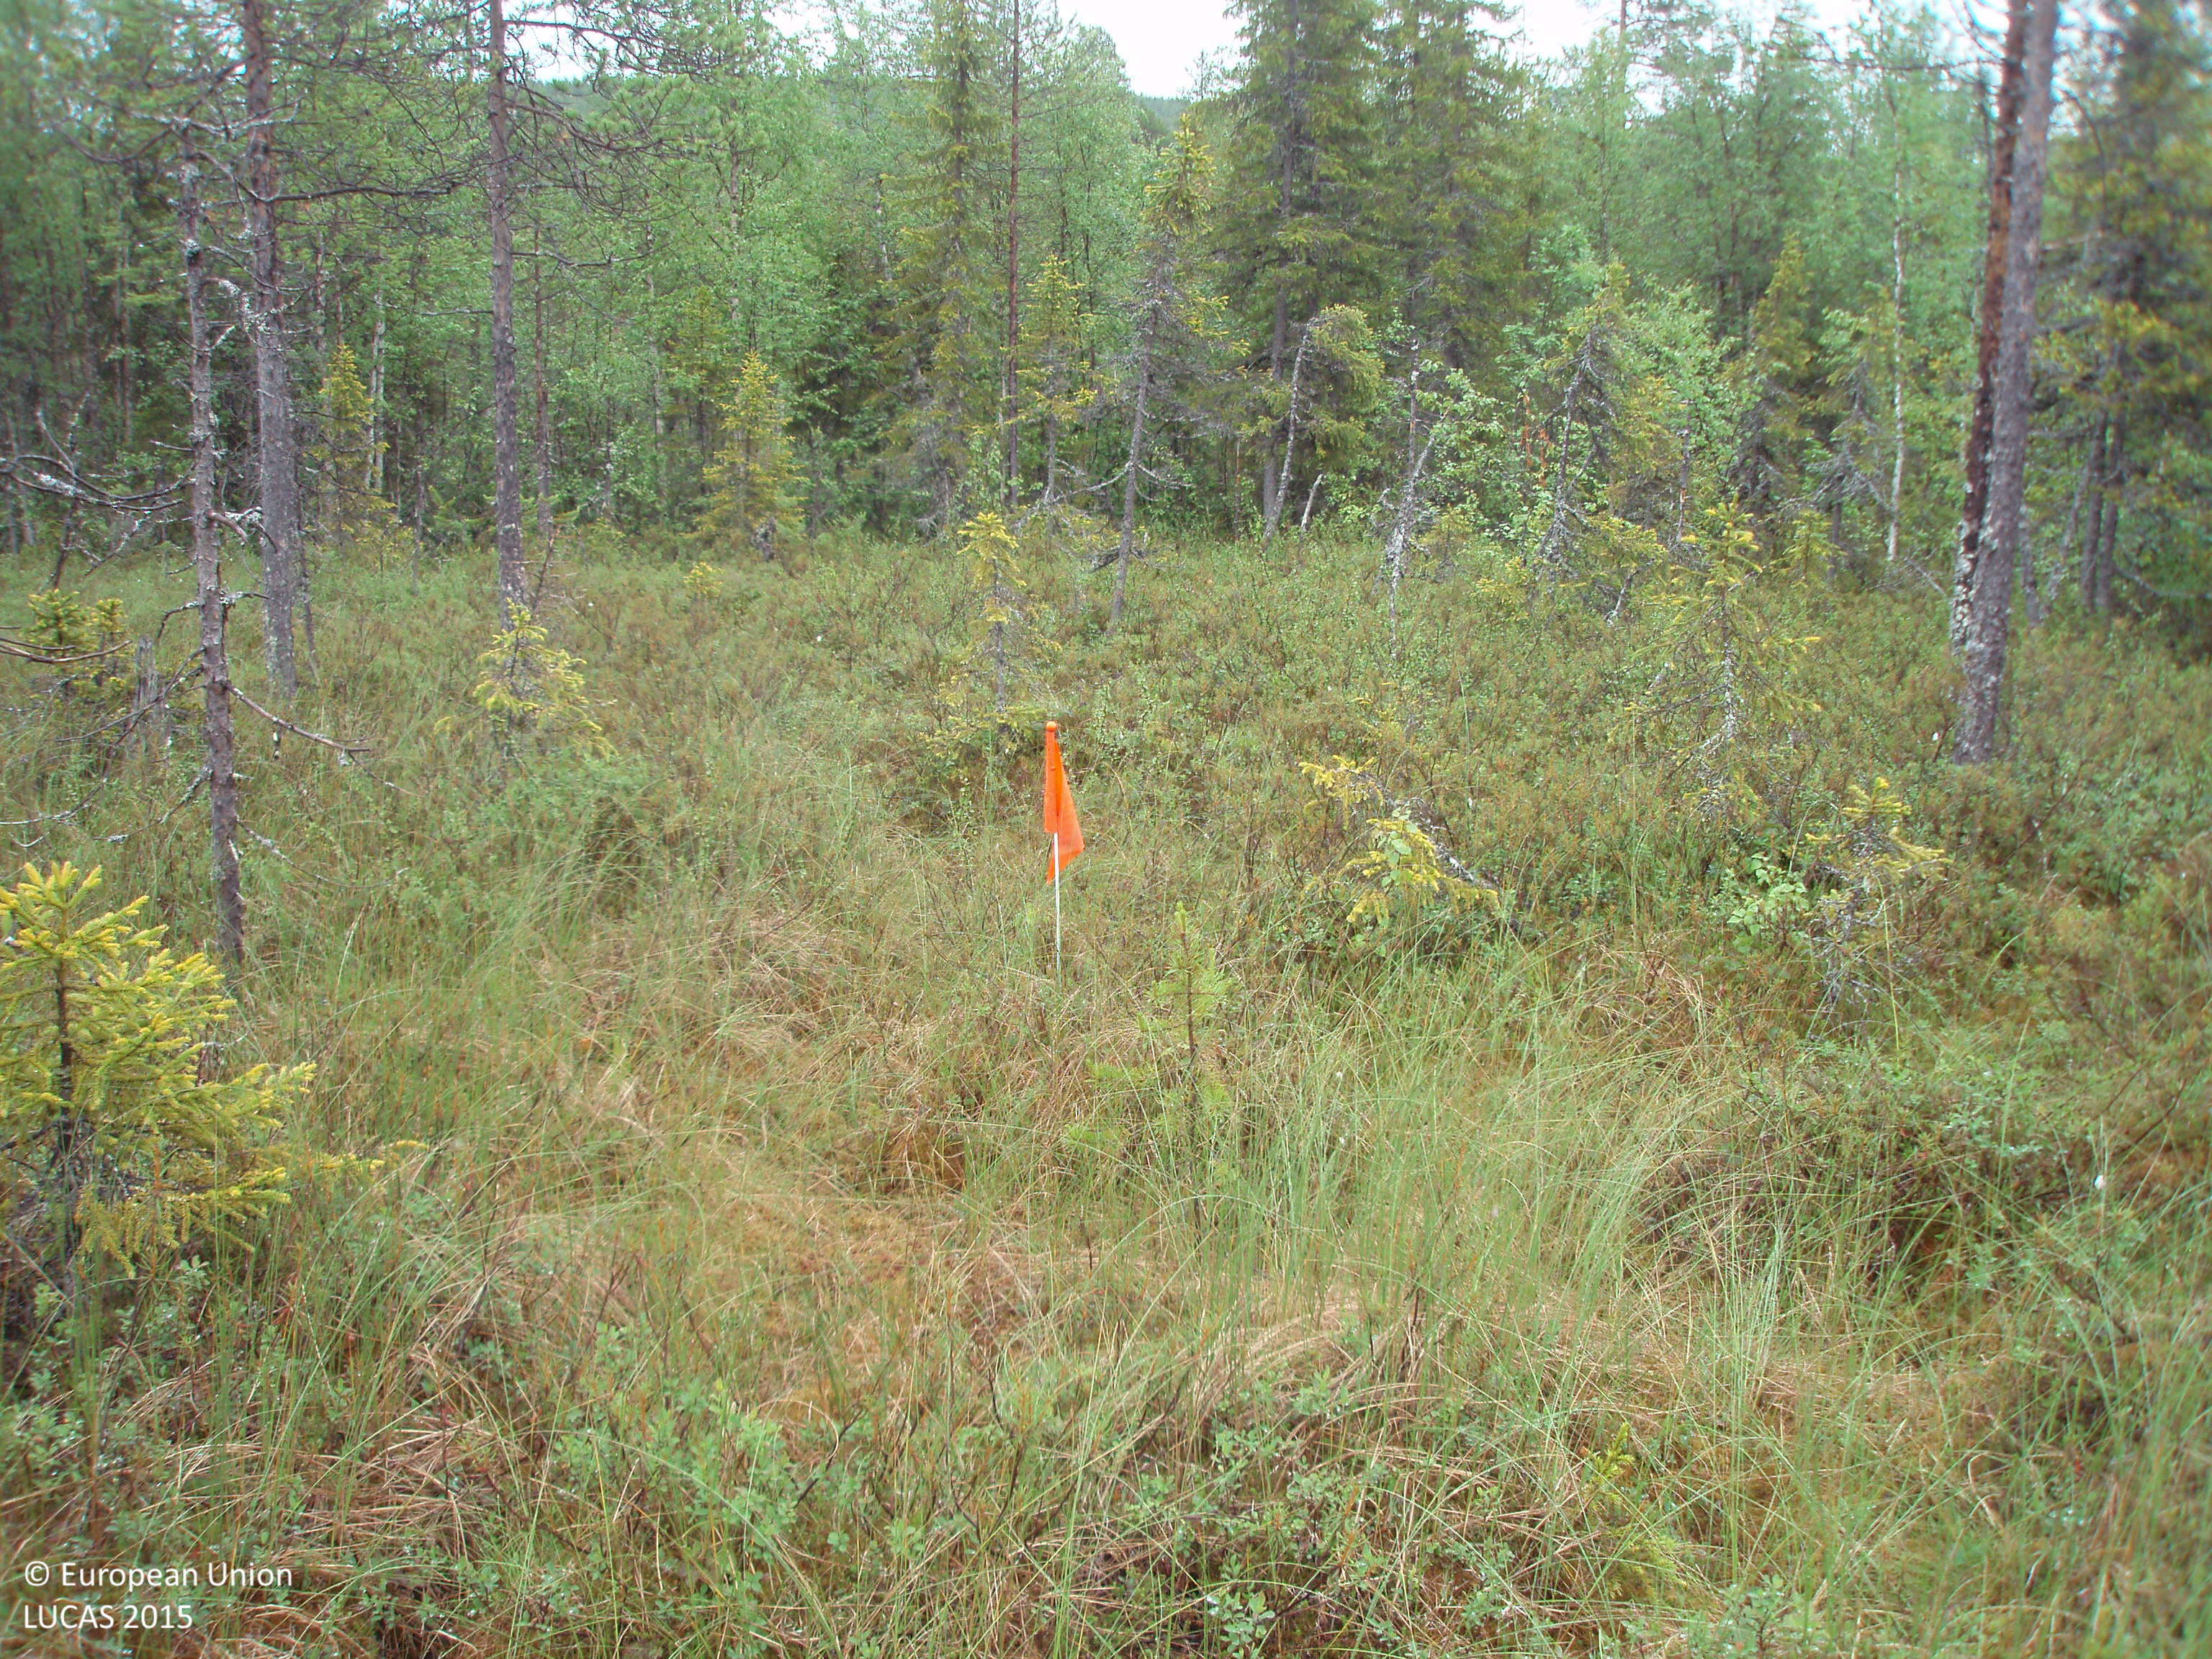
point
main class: Woodland
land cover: Pine dominated coniferous woodland
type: mire and swamp forests
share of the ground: 10 - 25 %
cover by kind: shrubs 70 %, coniferous forest trees 10 %, herbaceous plants 10 %, lichens and mosses 10 %
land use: Semi-natural and natural areas not in use
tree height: > 5 m
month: July
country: FI
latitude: 66.7806
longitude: 27.9199
